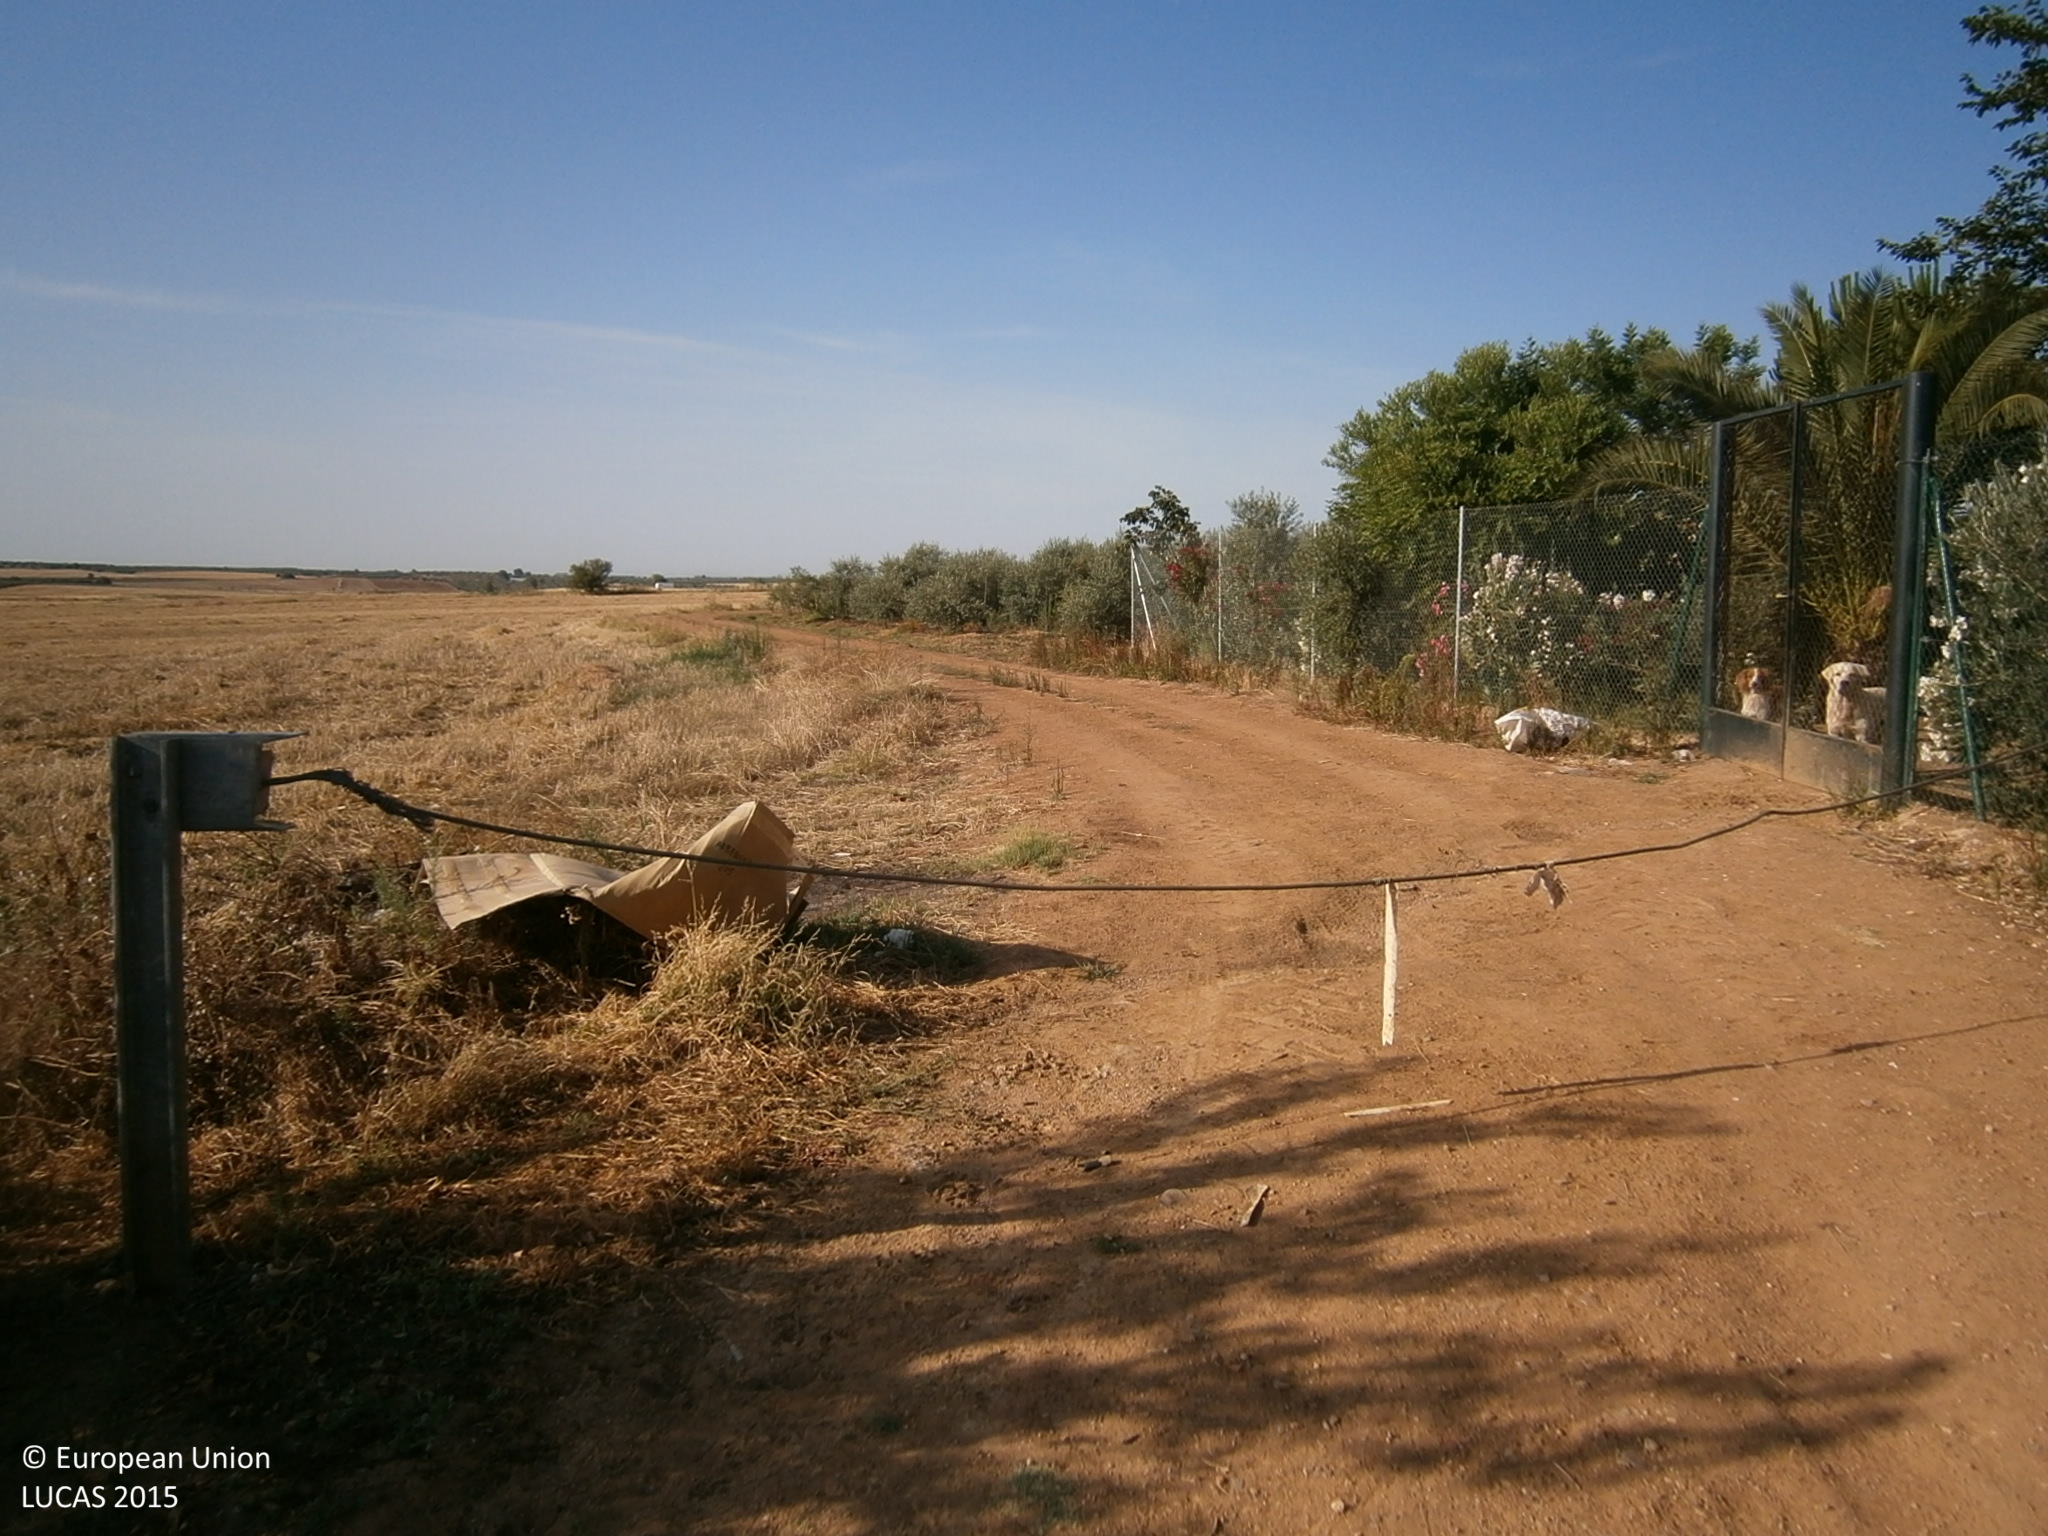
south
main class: Grassland
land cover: Grassland with sparse tree/shrub cover
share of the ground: > 75 %
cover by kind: herbaceous plants 90 %, broadleaved forest trees 5 %, unconsolidated bare surface 5 %
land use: Agriculture (excluding fallow land and kitchen gardens)
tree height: > 5 m
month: July
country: ES
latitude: 38.9900
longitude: -6.7026
